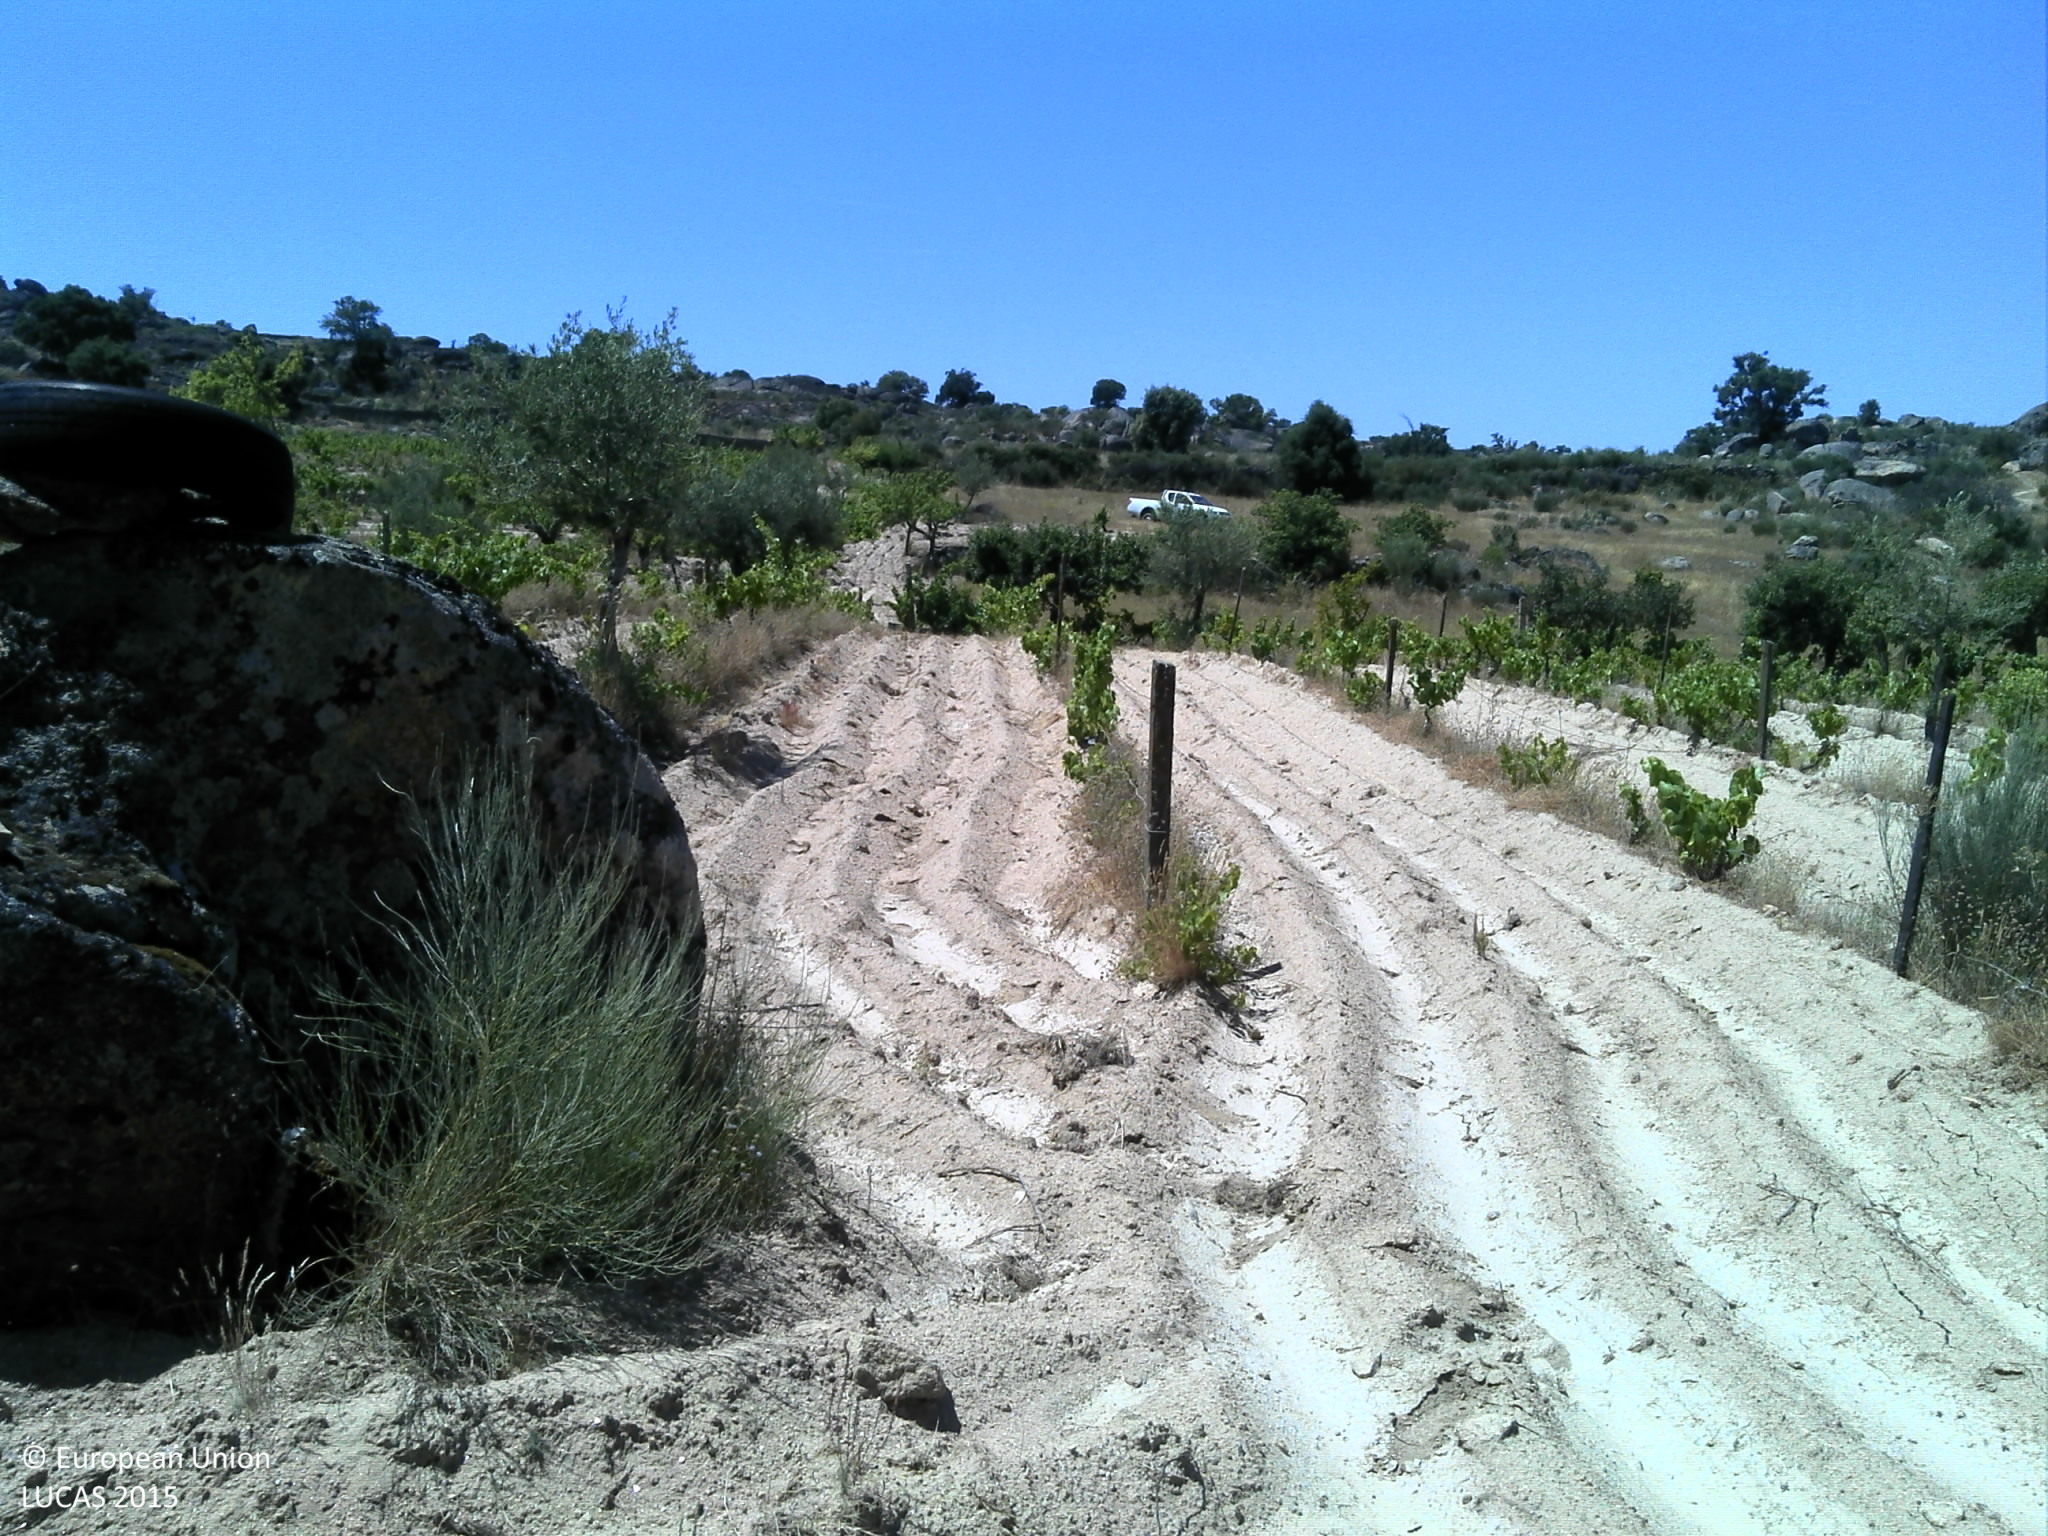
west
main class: Cropland
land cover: Vineyards
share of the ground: < 10 %
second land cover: Other bare soil
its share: > 75 %
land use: Agriculture (excluding fallow land and kitchen gardens)
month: June
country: PT
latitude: 40.9274
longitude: -7.0046
